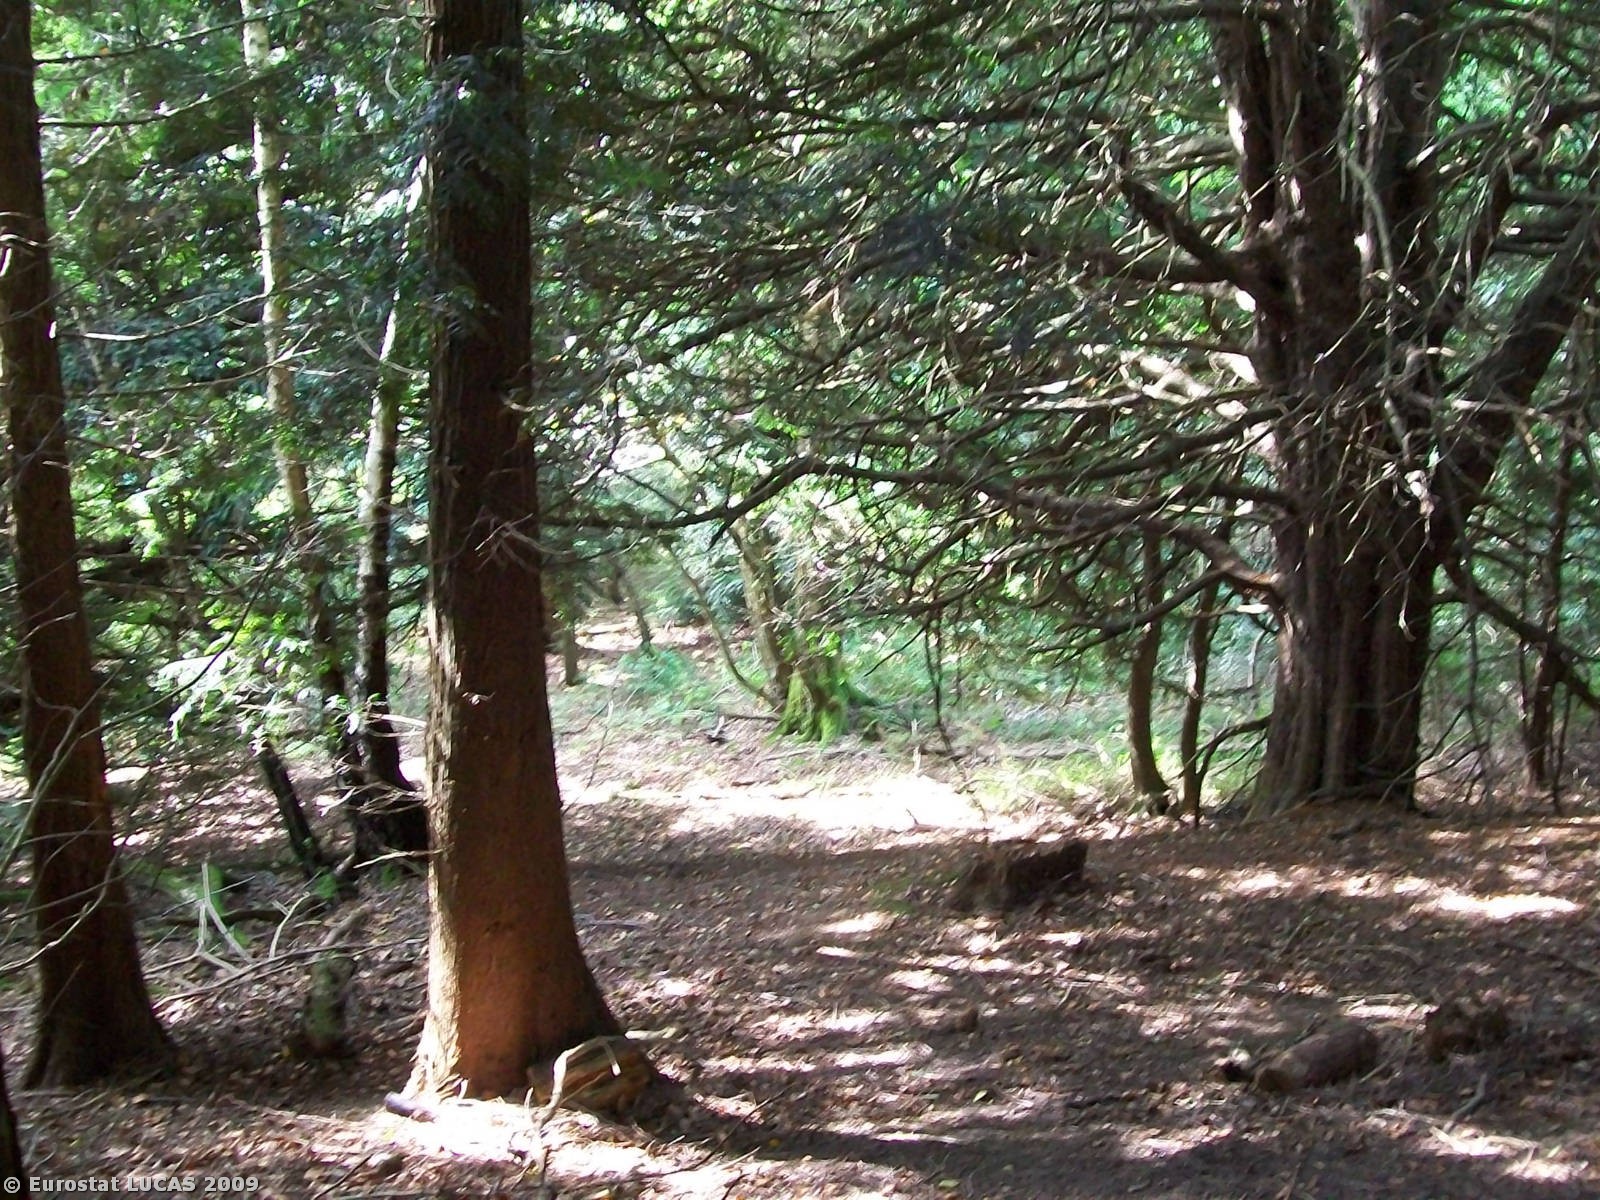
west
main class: Woodland
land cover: Coniferous woodland
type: plantations and self-sown exotic forest
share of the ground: > 75 %
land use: Community services
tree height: > 5 m
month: September
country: GB
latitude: 52.0324
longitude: -2.4112
